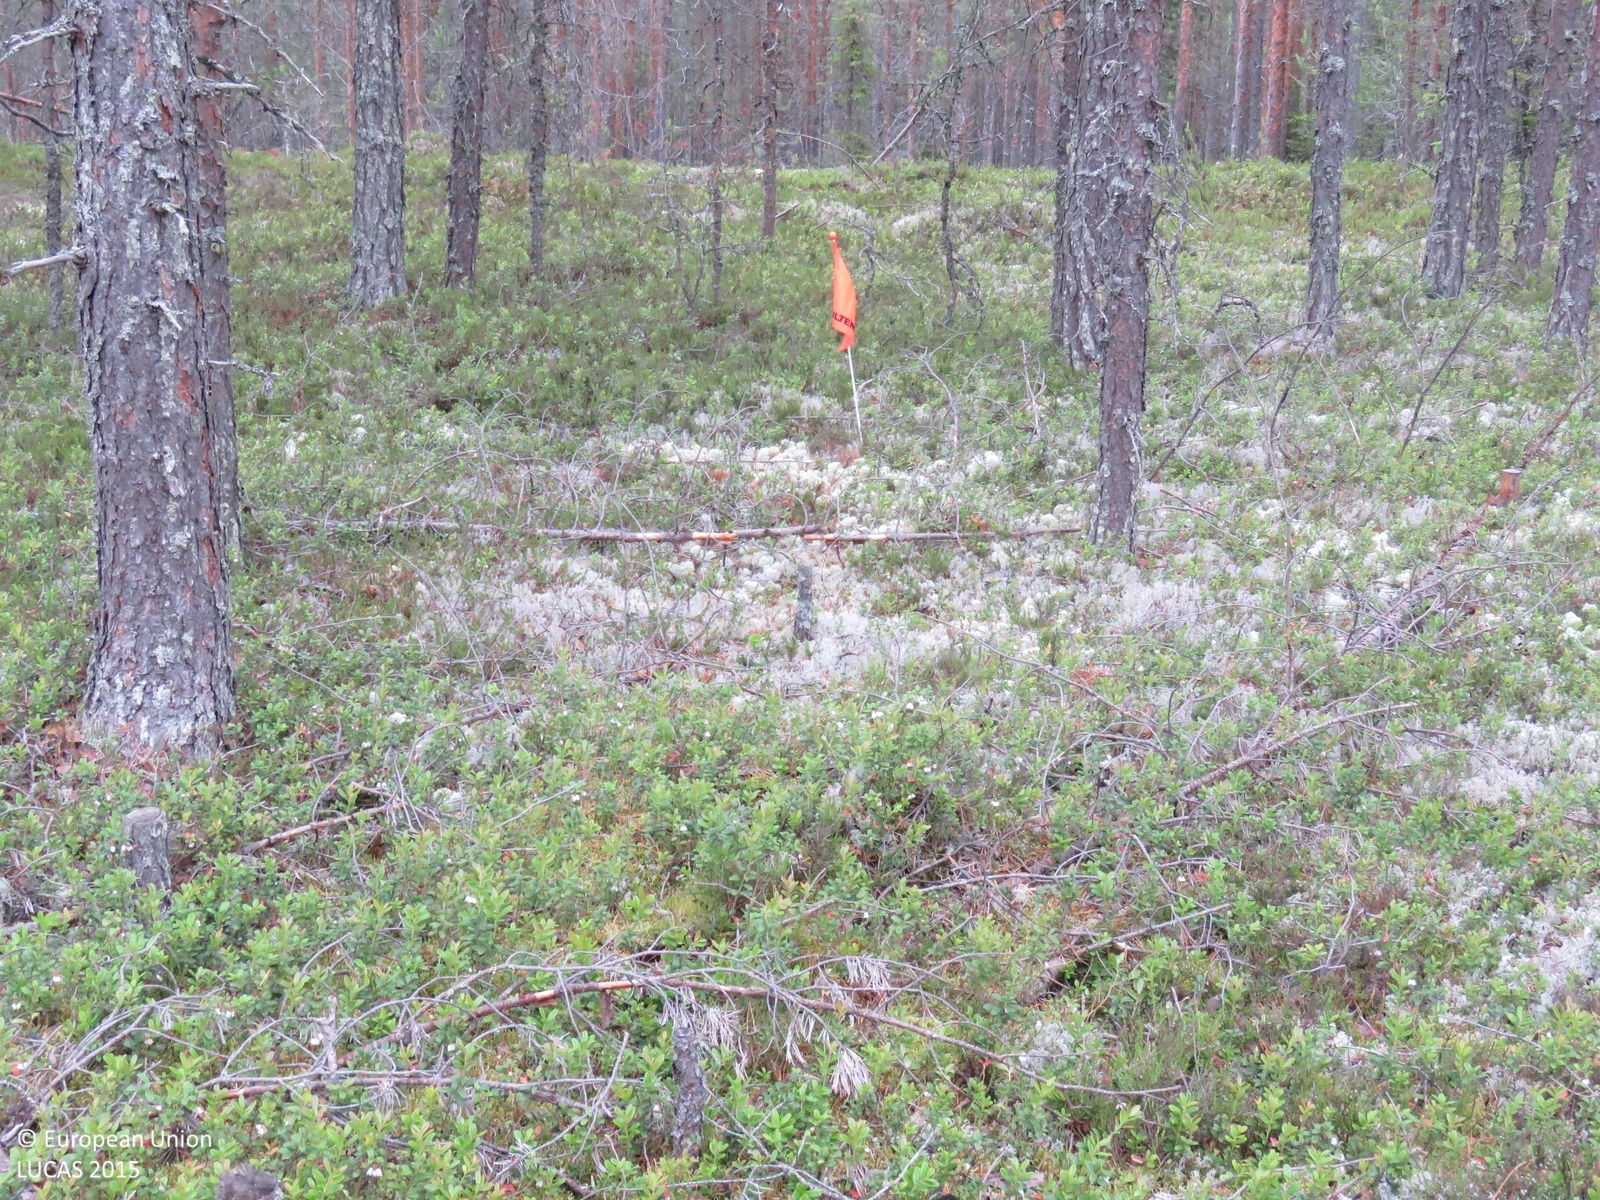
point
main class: Woodland
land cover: Pine dominated coniferous woodland
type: boreal forest
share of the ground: > 75 %
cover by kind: coniferous forest trees 80 %, shrubs 10 %, lichens and mosses 10 %
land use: Forestry
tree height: > 5 m
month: July
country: FI
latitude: 64.3241
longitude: 26.3086
